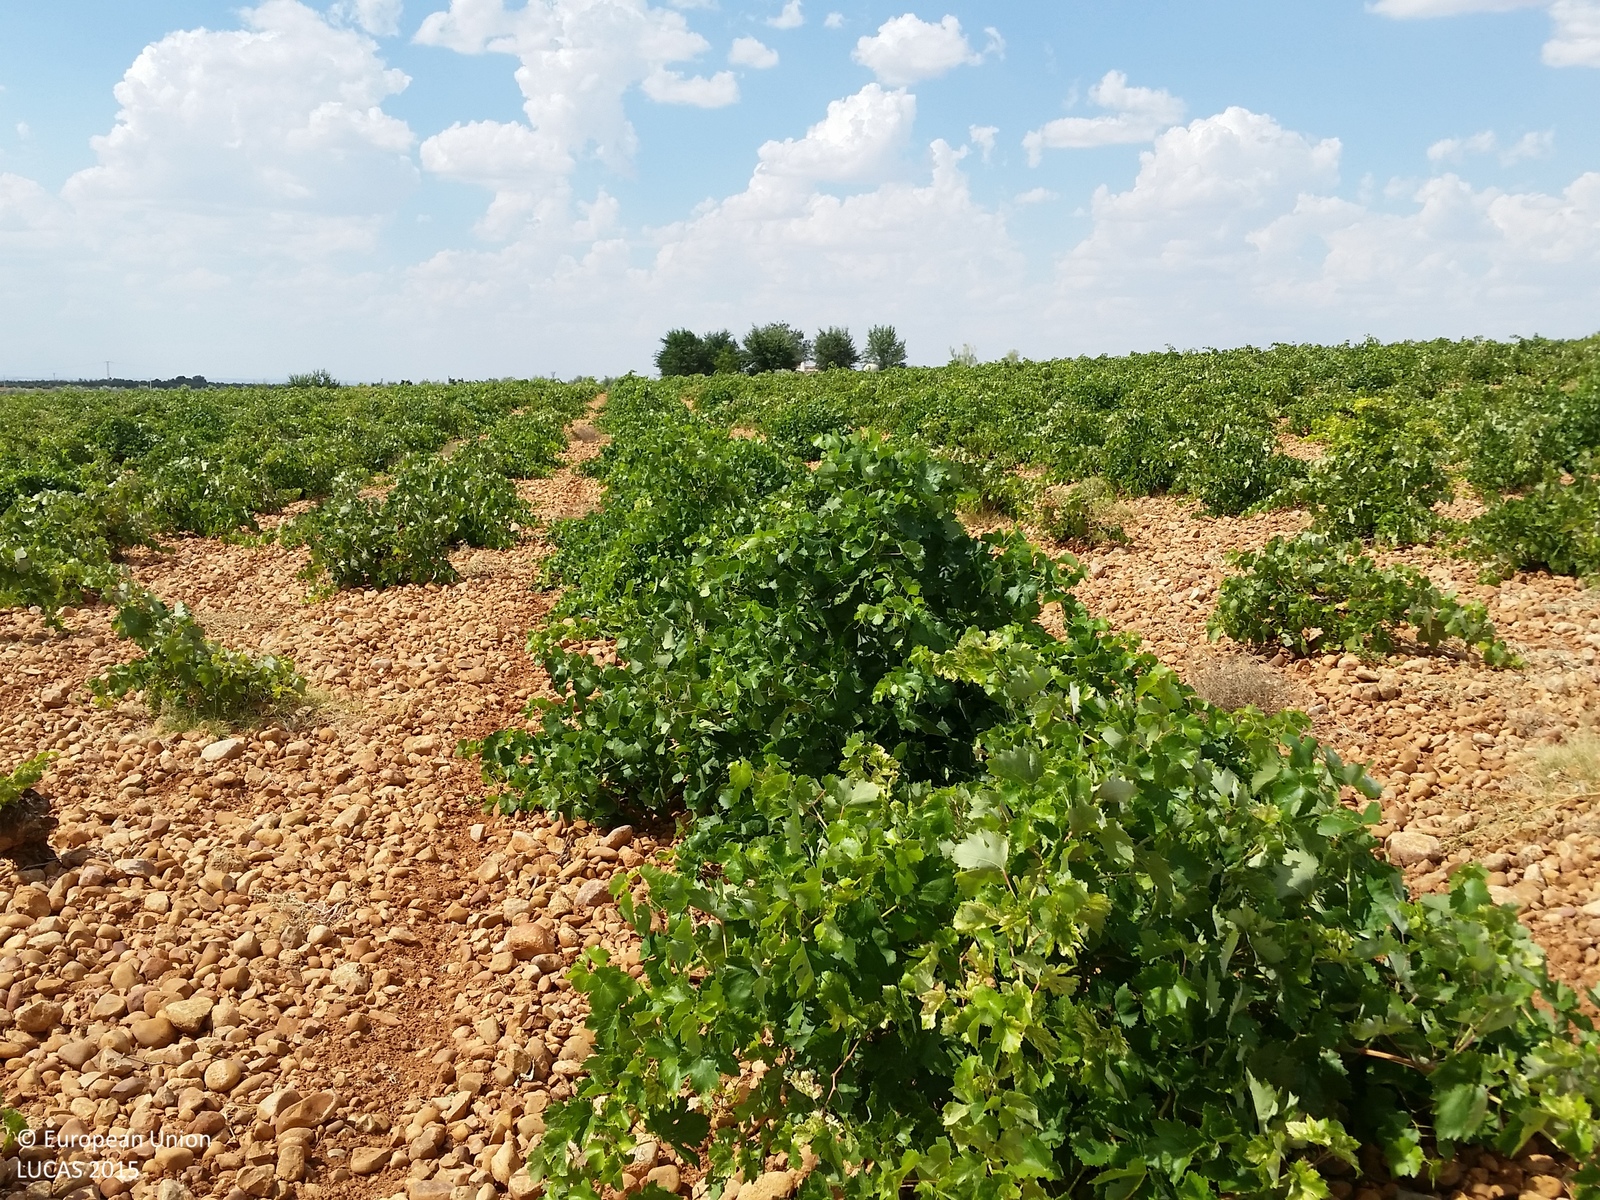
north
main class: Cropland
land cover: Vineyards
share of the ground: 50 - 75 %
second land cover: Other bare soil
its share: > 75 %
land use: Agriculture (excluding fallow land and kitchen gardens)
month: July
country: ES
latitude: 39.2049
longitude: -2.6670
